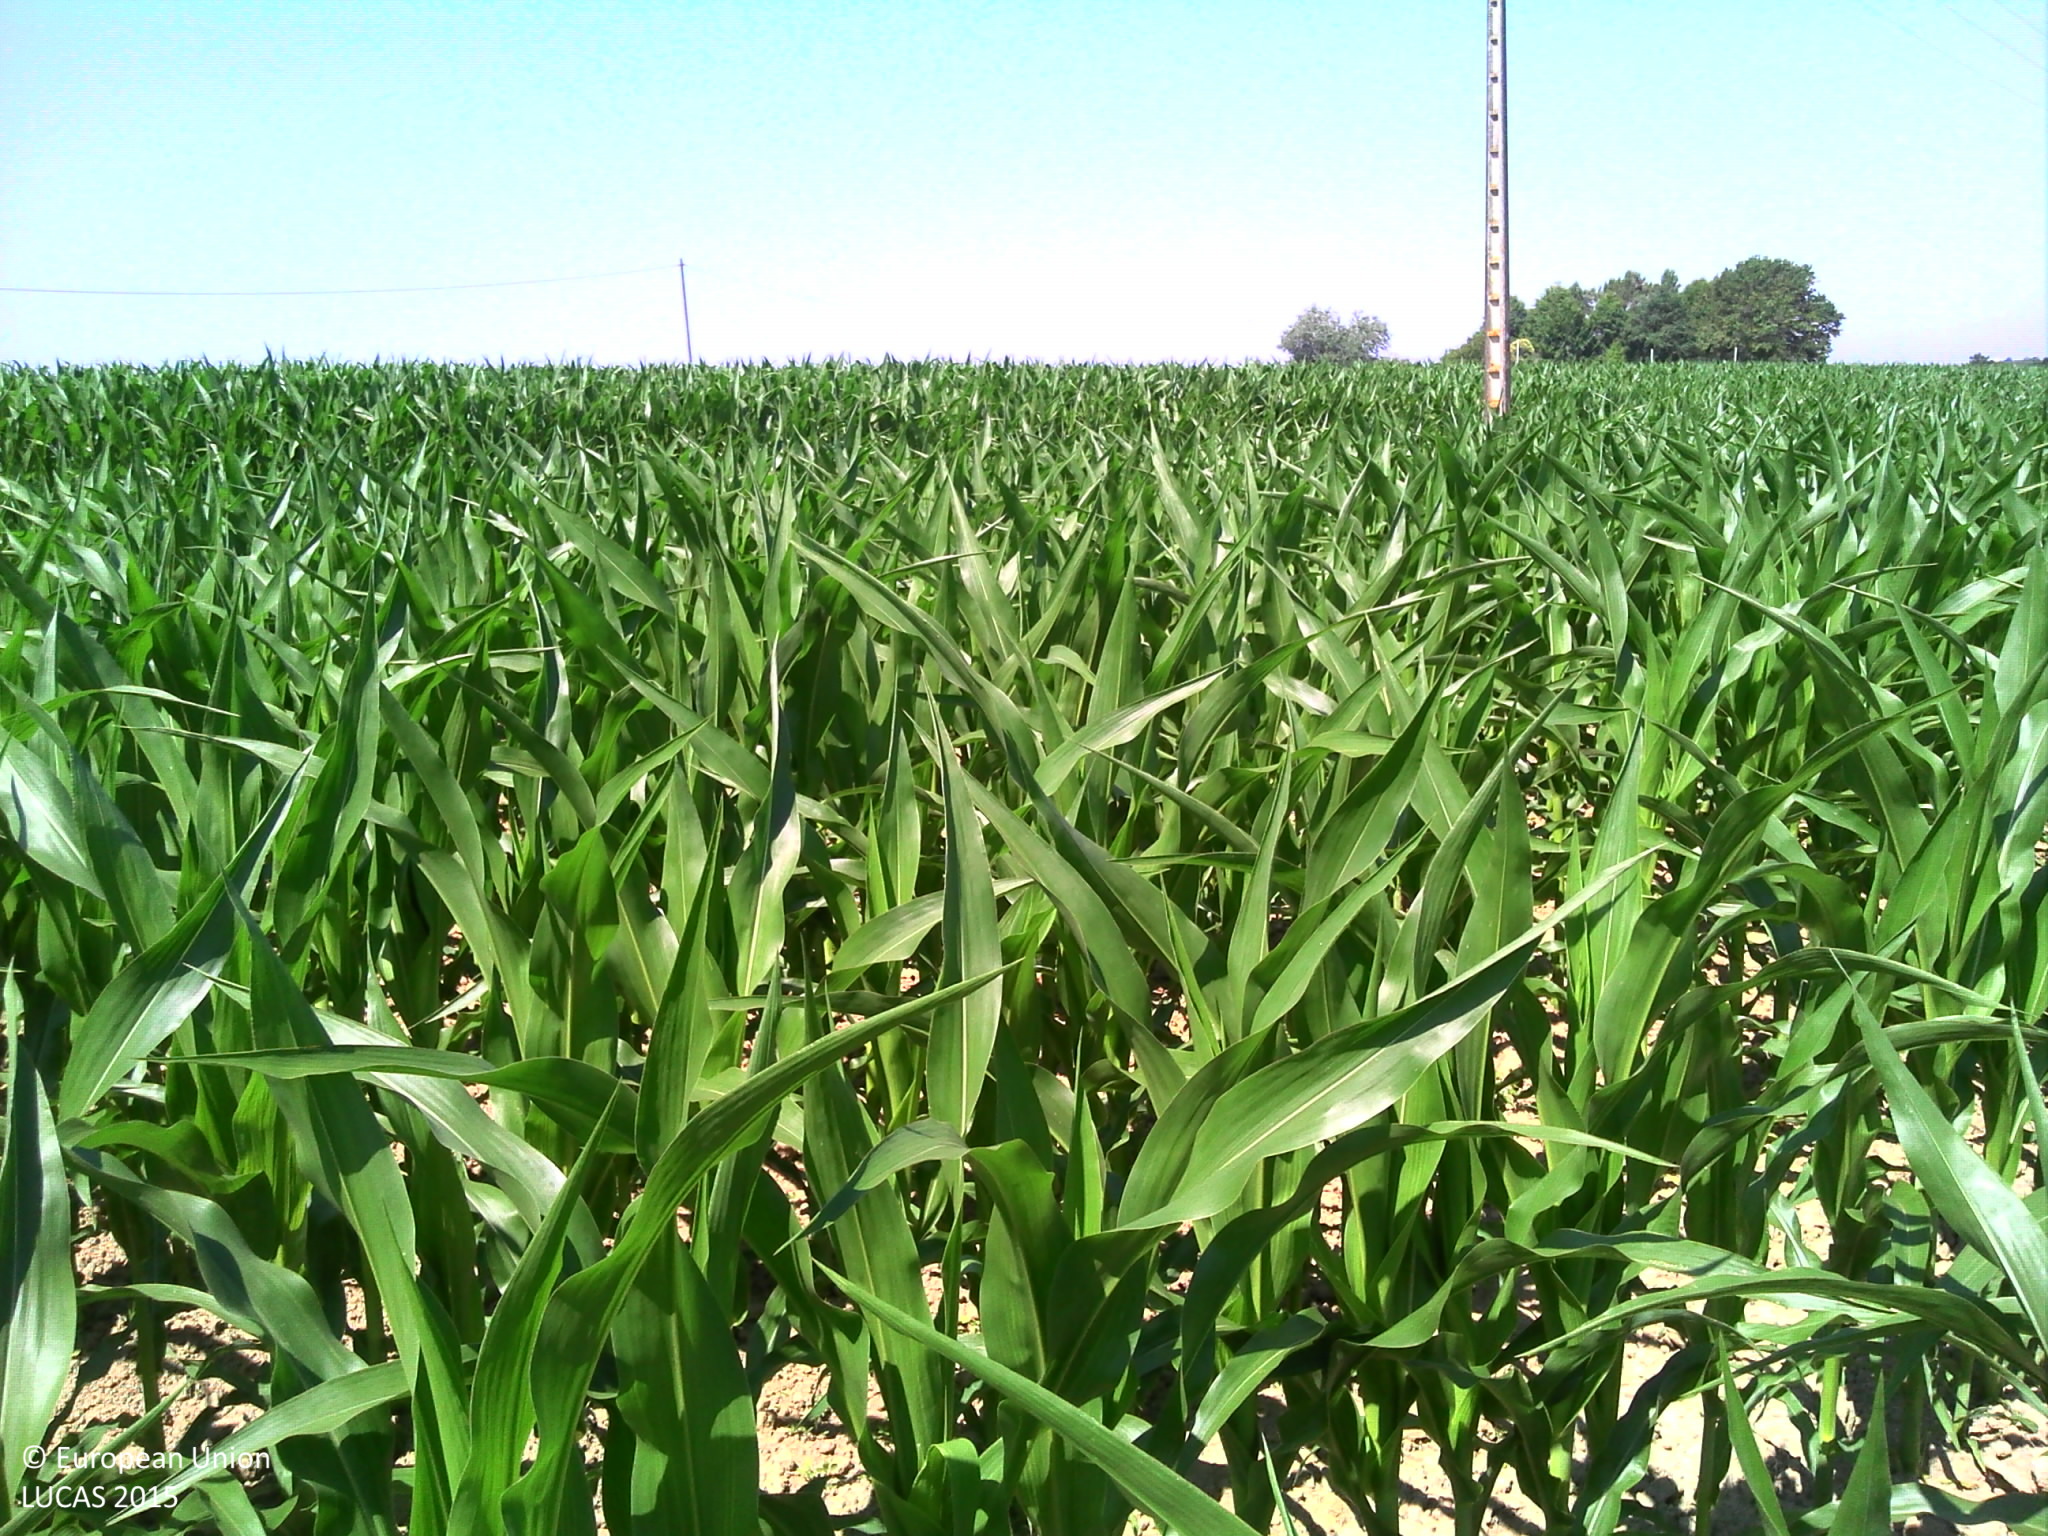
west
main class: Cropland
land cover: Maize
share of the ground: > 75 %
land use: Agriculture (excluding fallow land and kitchen gardens)
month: June
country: FR
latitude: 43.6108
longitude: -0.5545
